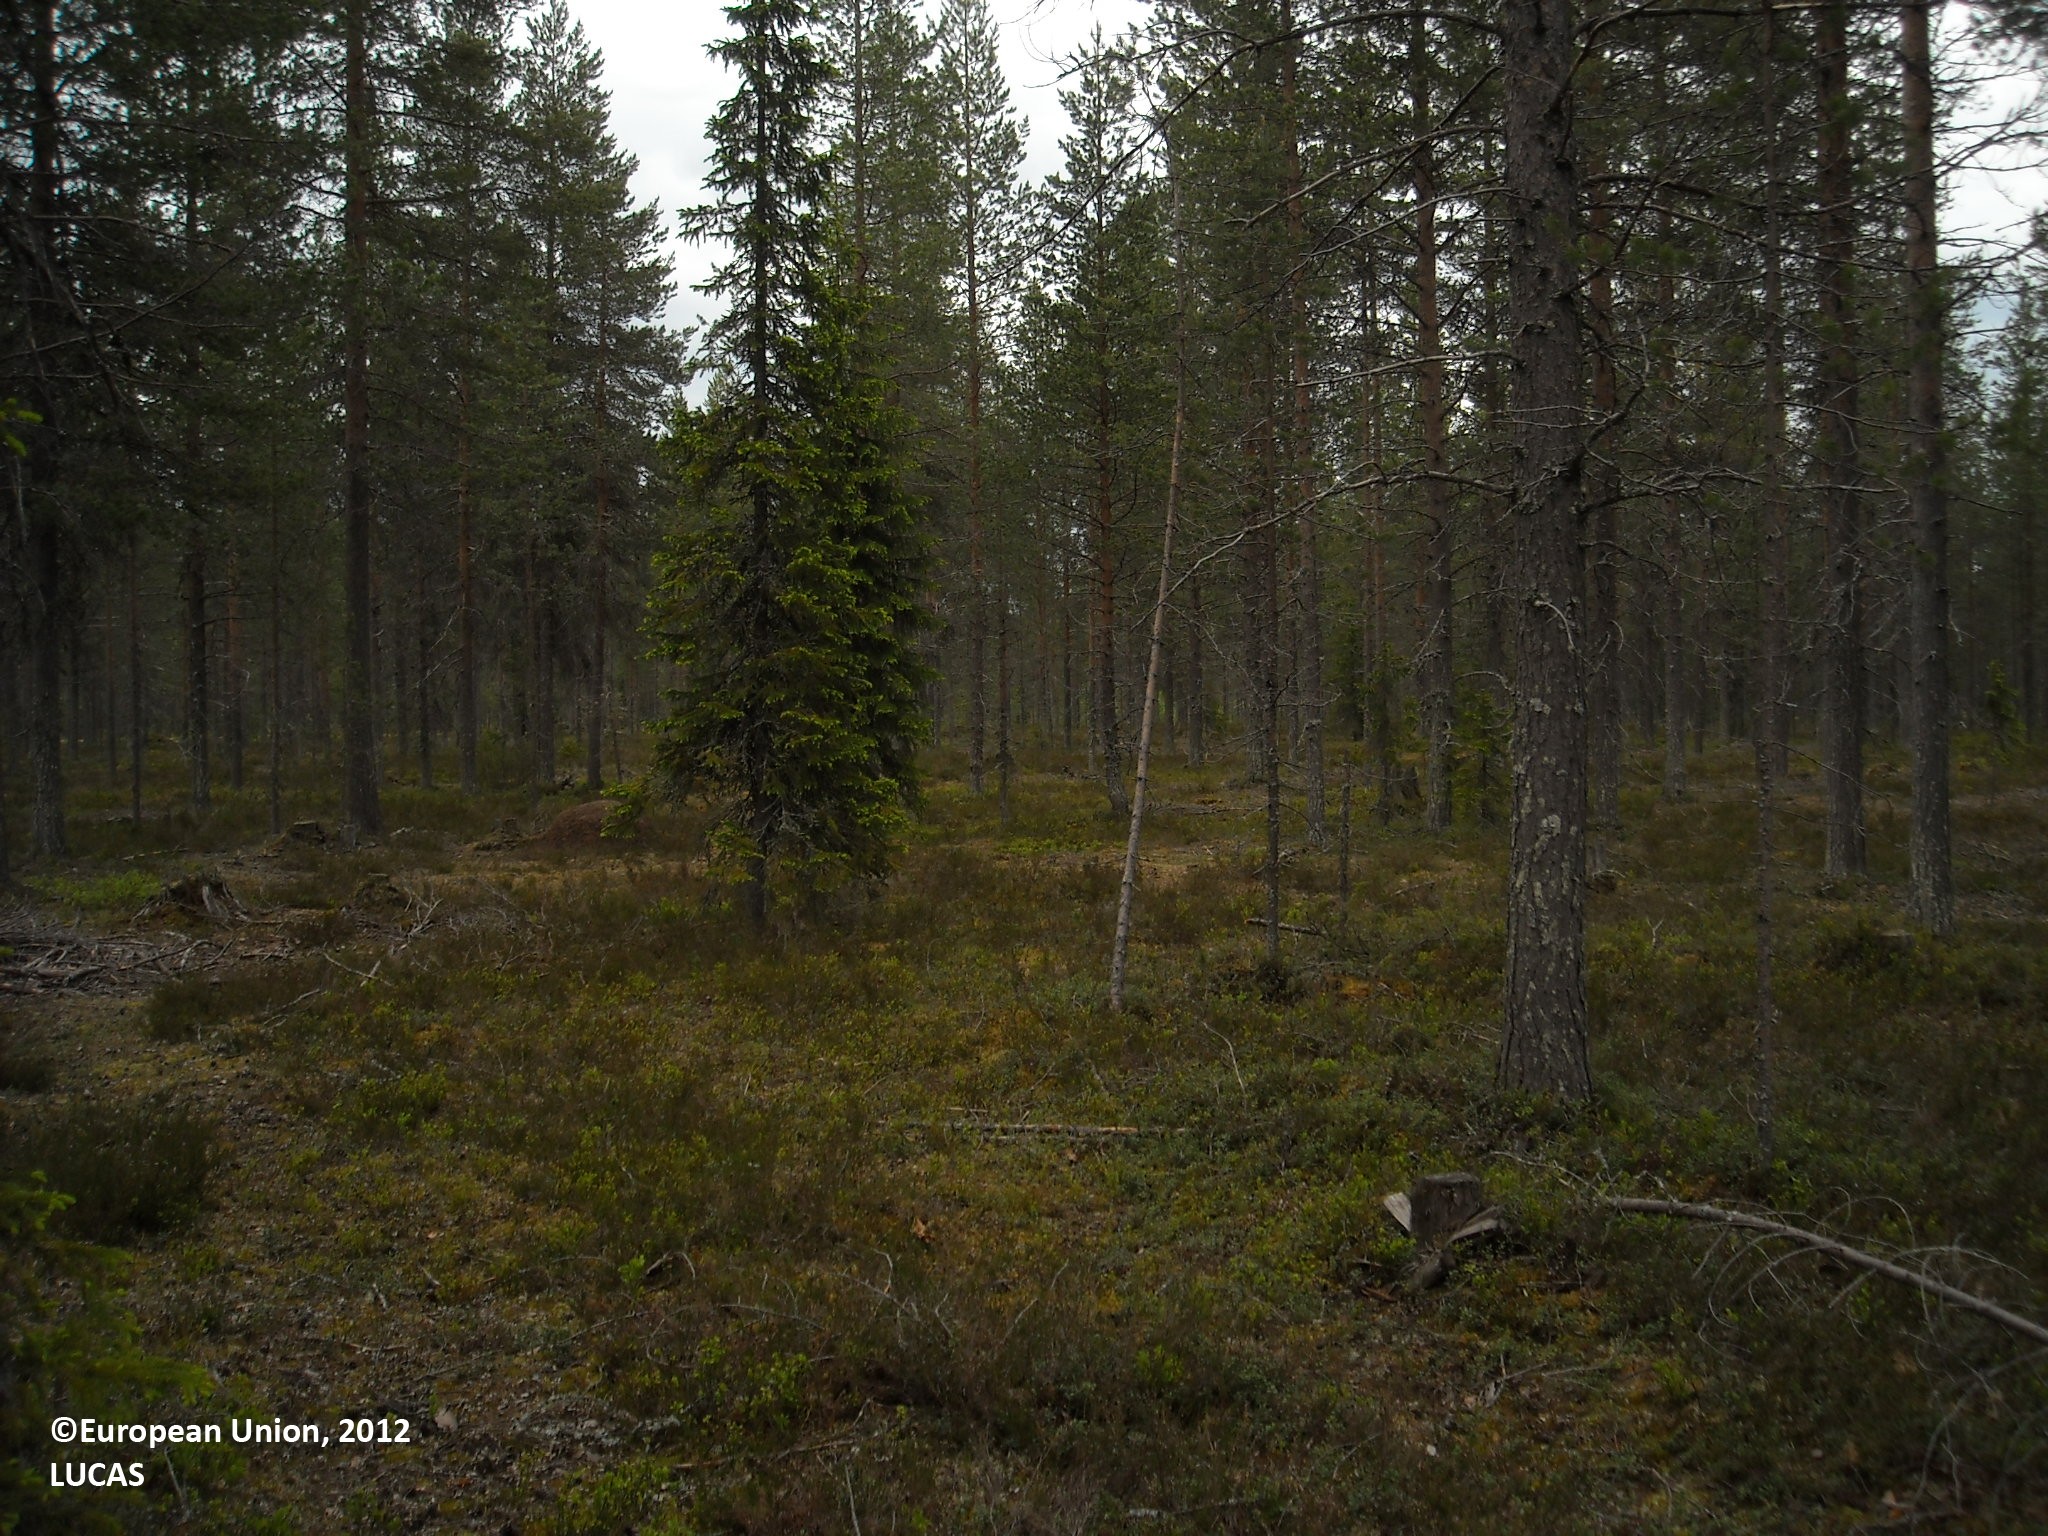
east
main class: Woodland
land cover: Pine dominated coniferous woodland
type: boreal forest
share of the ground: 50 - 75 %
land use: Forestry
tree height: > 5 m
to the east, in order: Pine dominated coniferous woodland; Ditches and canals; Abandoned hedges; Paved roads, cycling and walking lanes; Abandoned hedges
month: June
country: FI
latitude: 65.5469
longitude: 27.9162
